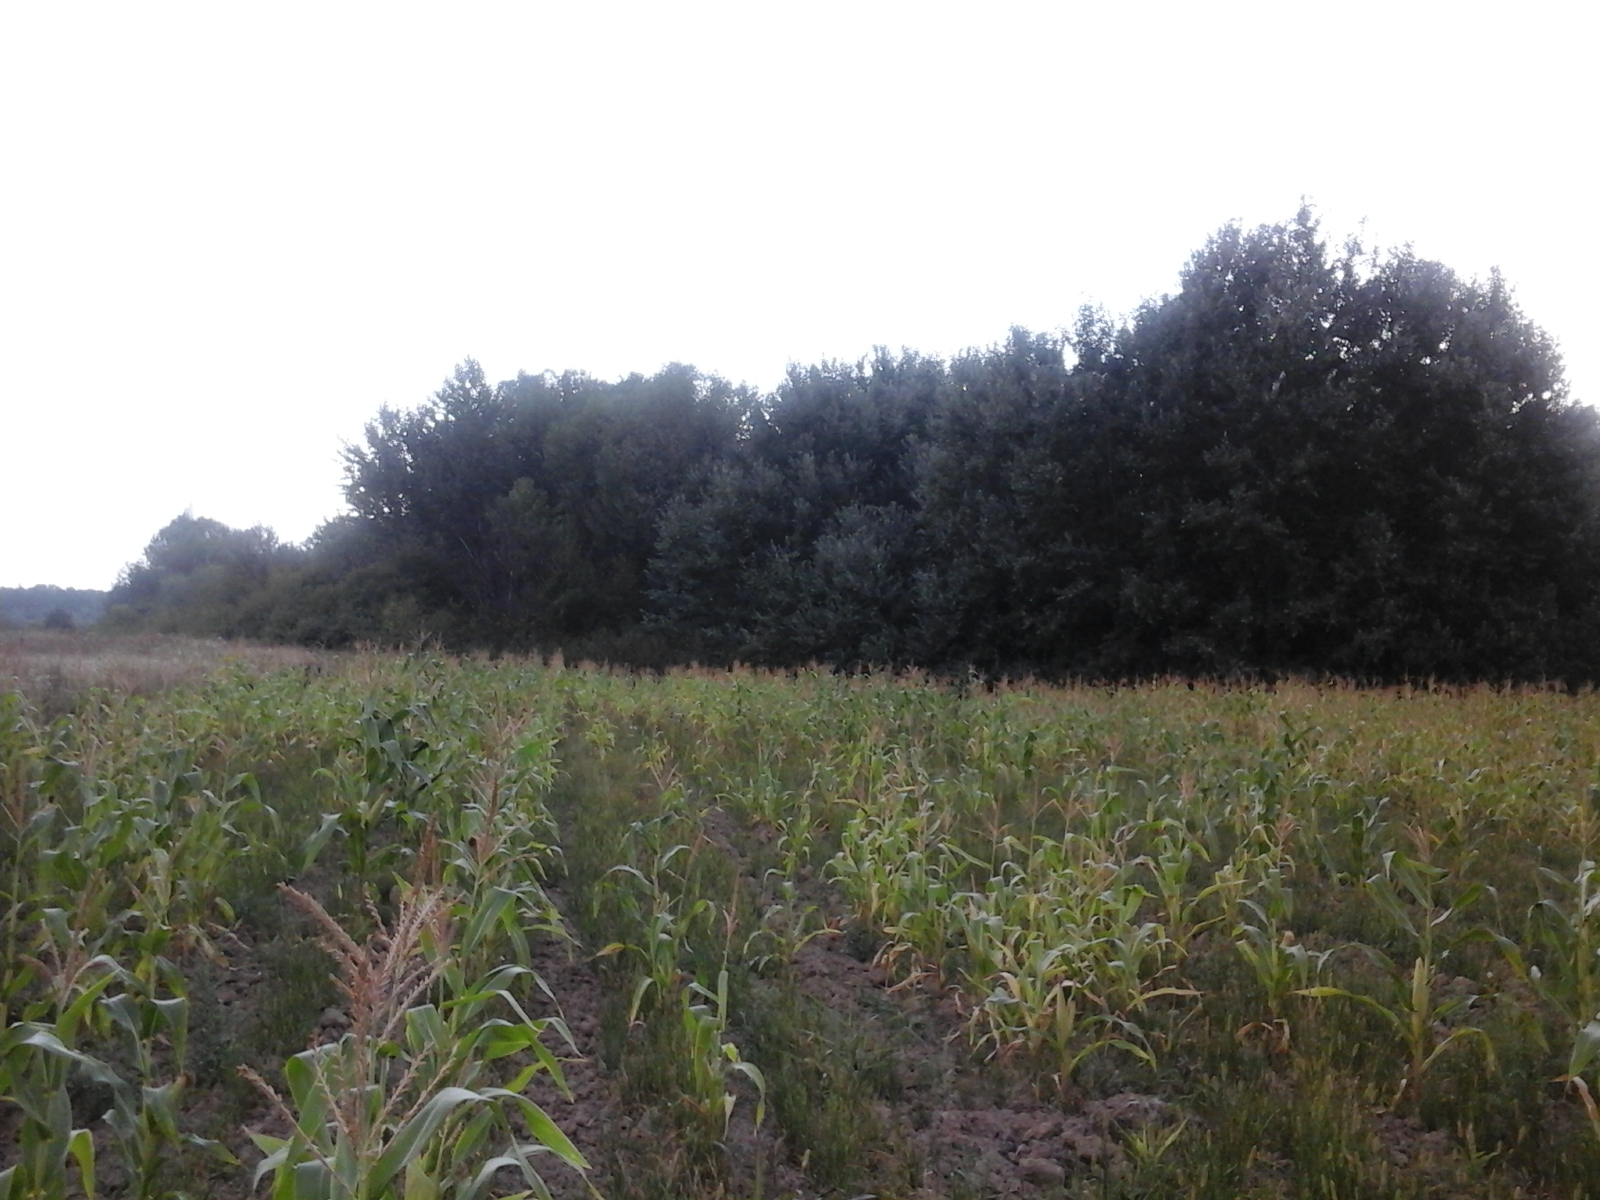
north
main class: Cropland
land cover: Maize
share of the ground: 25 - 50 %
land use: Agriculture (excluding fallow land and kitchen gardens)
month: August
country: RO
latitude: 44.6418
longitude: 23.4300
